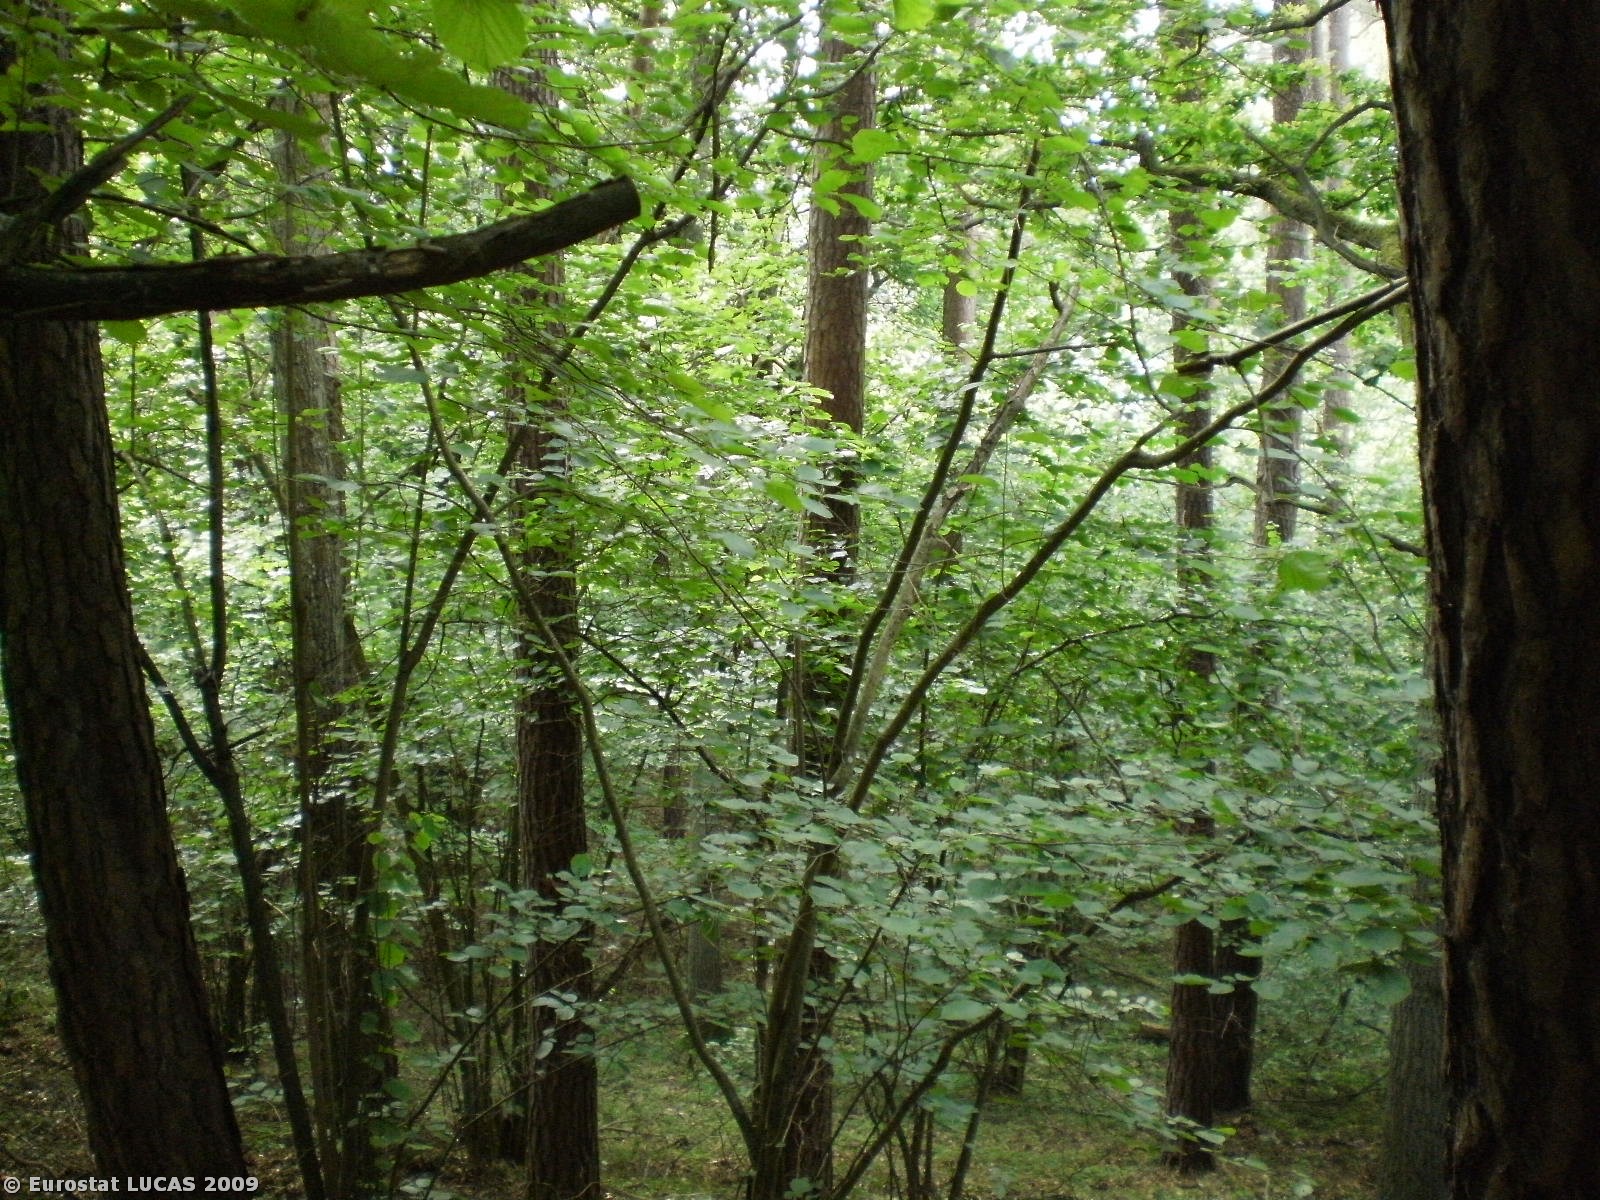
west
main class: Woodland
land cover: Mixed woodland
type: hemiboreal forest and nemoral coniferous forest and mixed broadleaved-coniferous forest
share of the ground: > 75 %
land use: Forestry
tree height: > 5 m
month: July
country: PL
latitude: 53.5608
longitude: 20.4994
